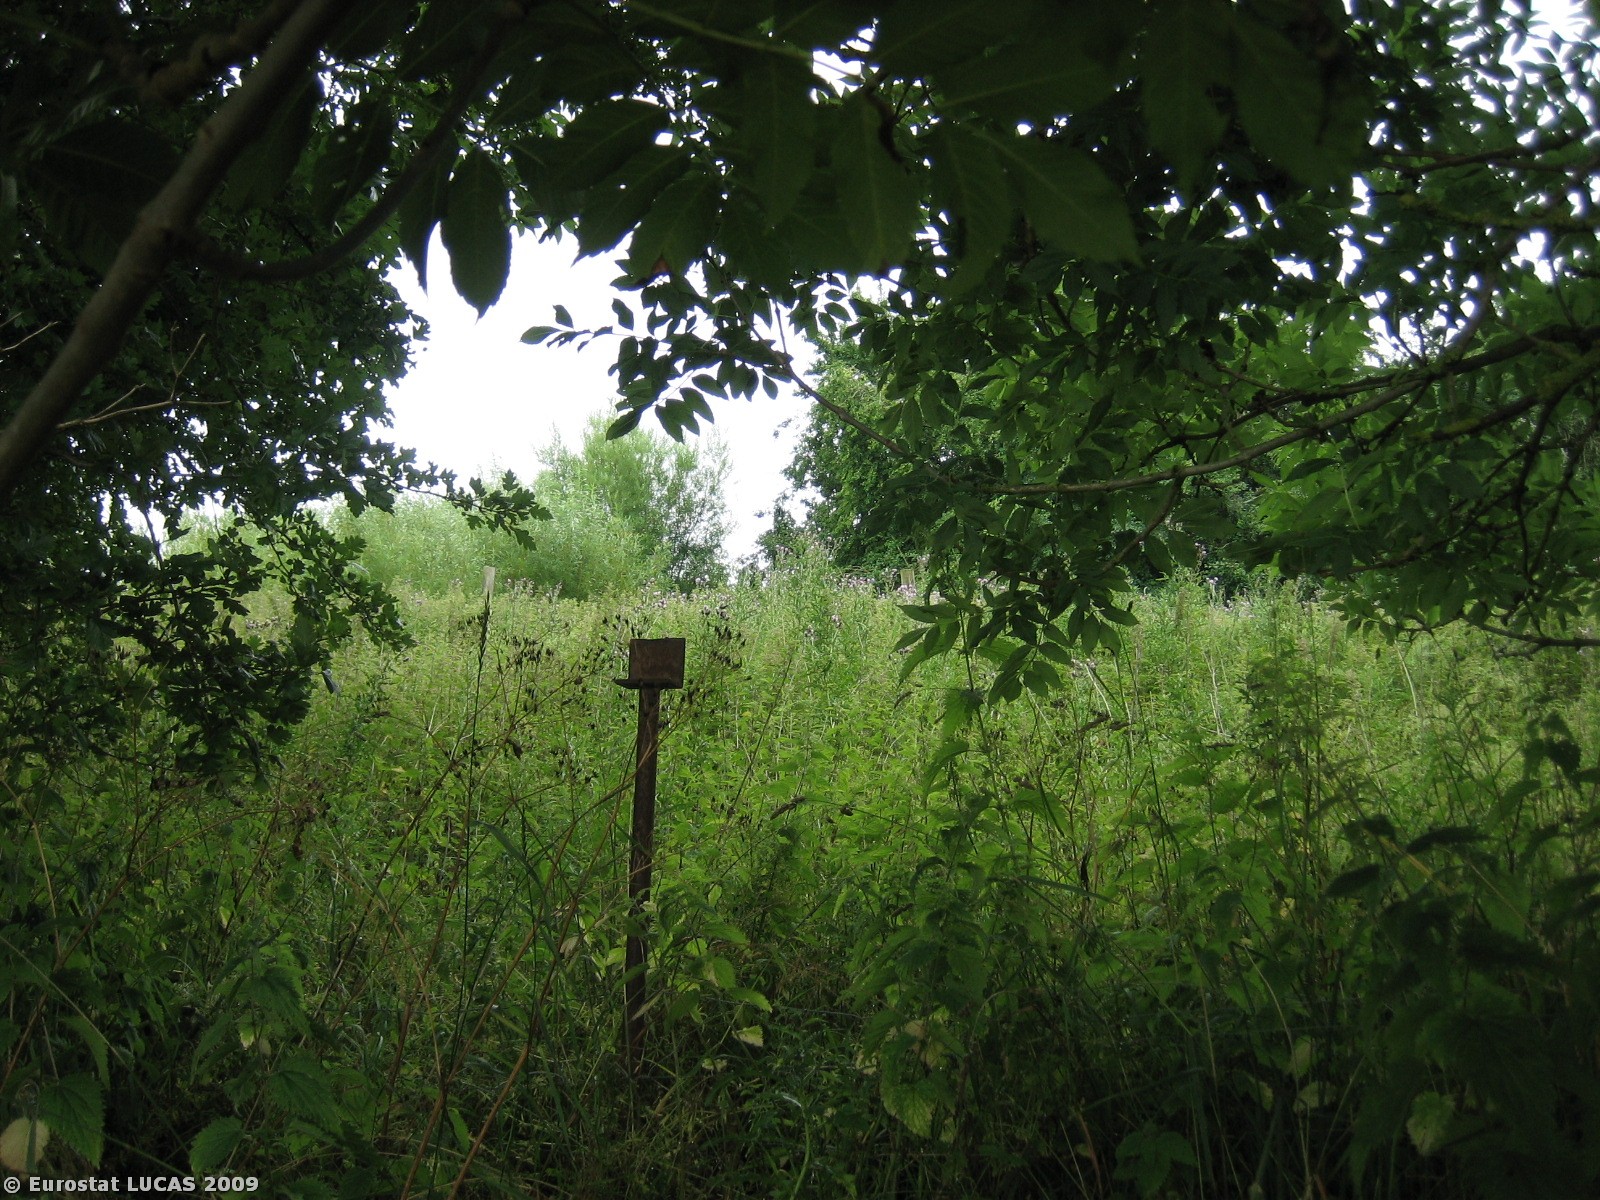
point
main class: Grassland
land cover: Grassland without tree/shrub cover
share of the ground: > 75 %
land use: Unused
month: July
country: DK
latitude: 55.2710
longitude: 9.9843
